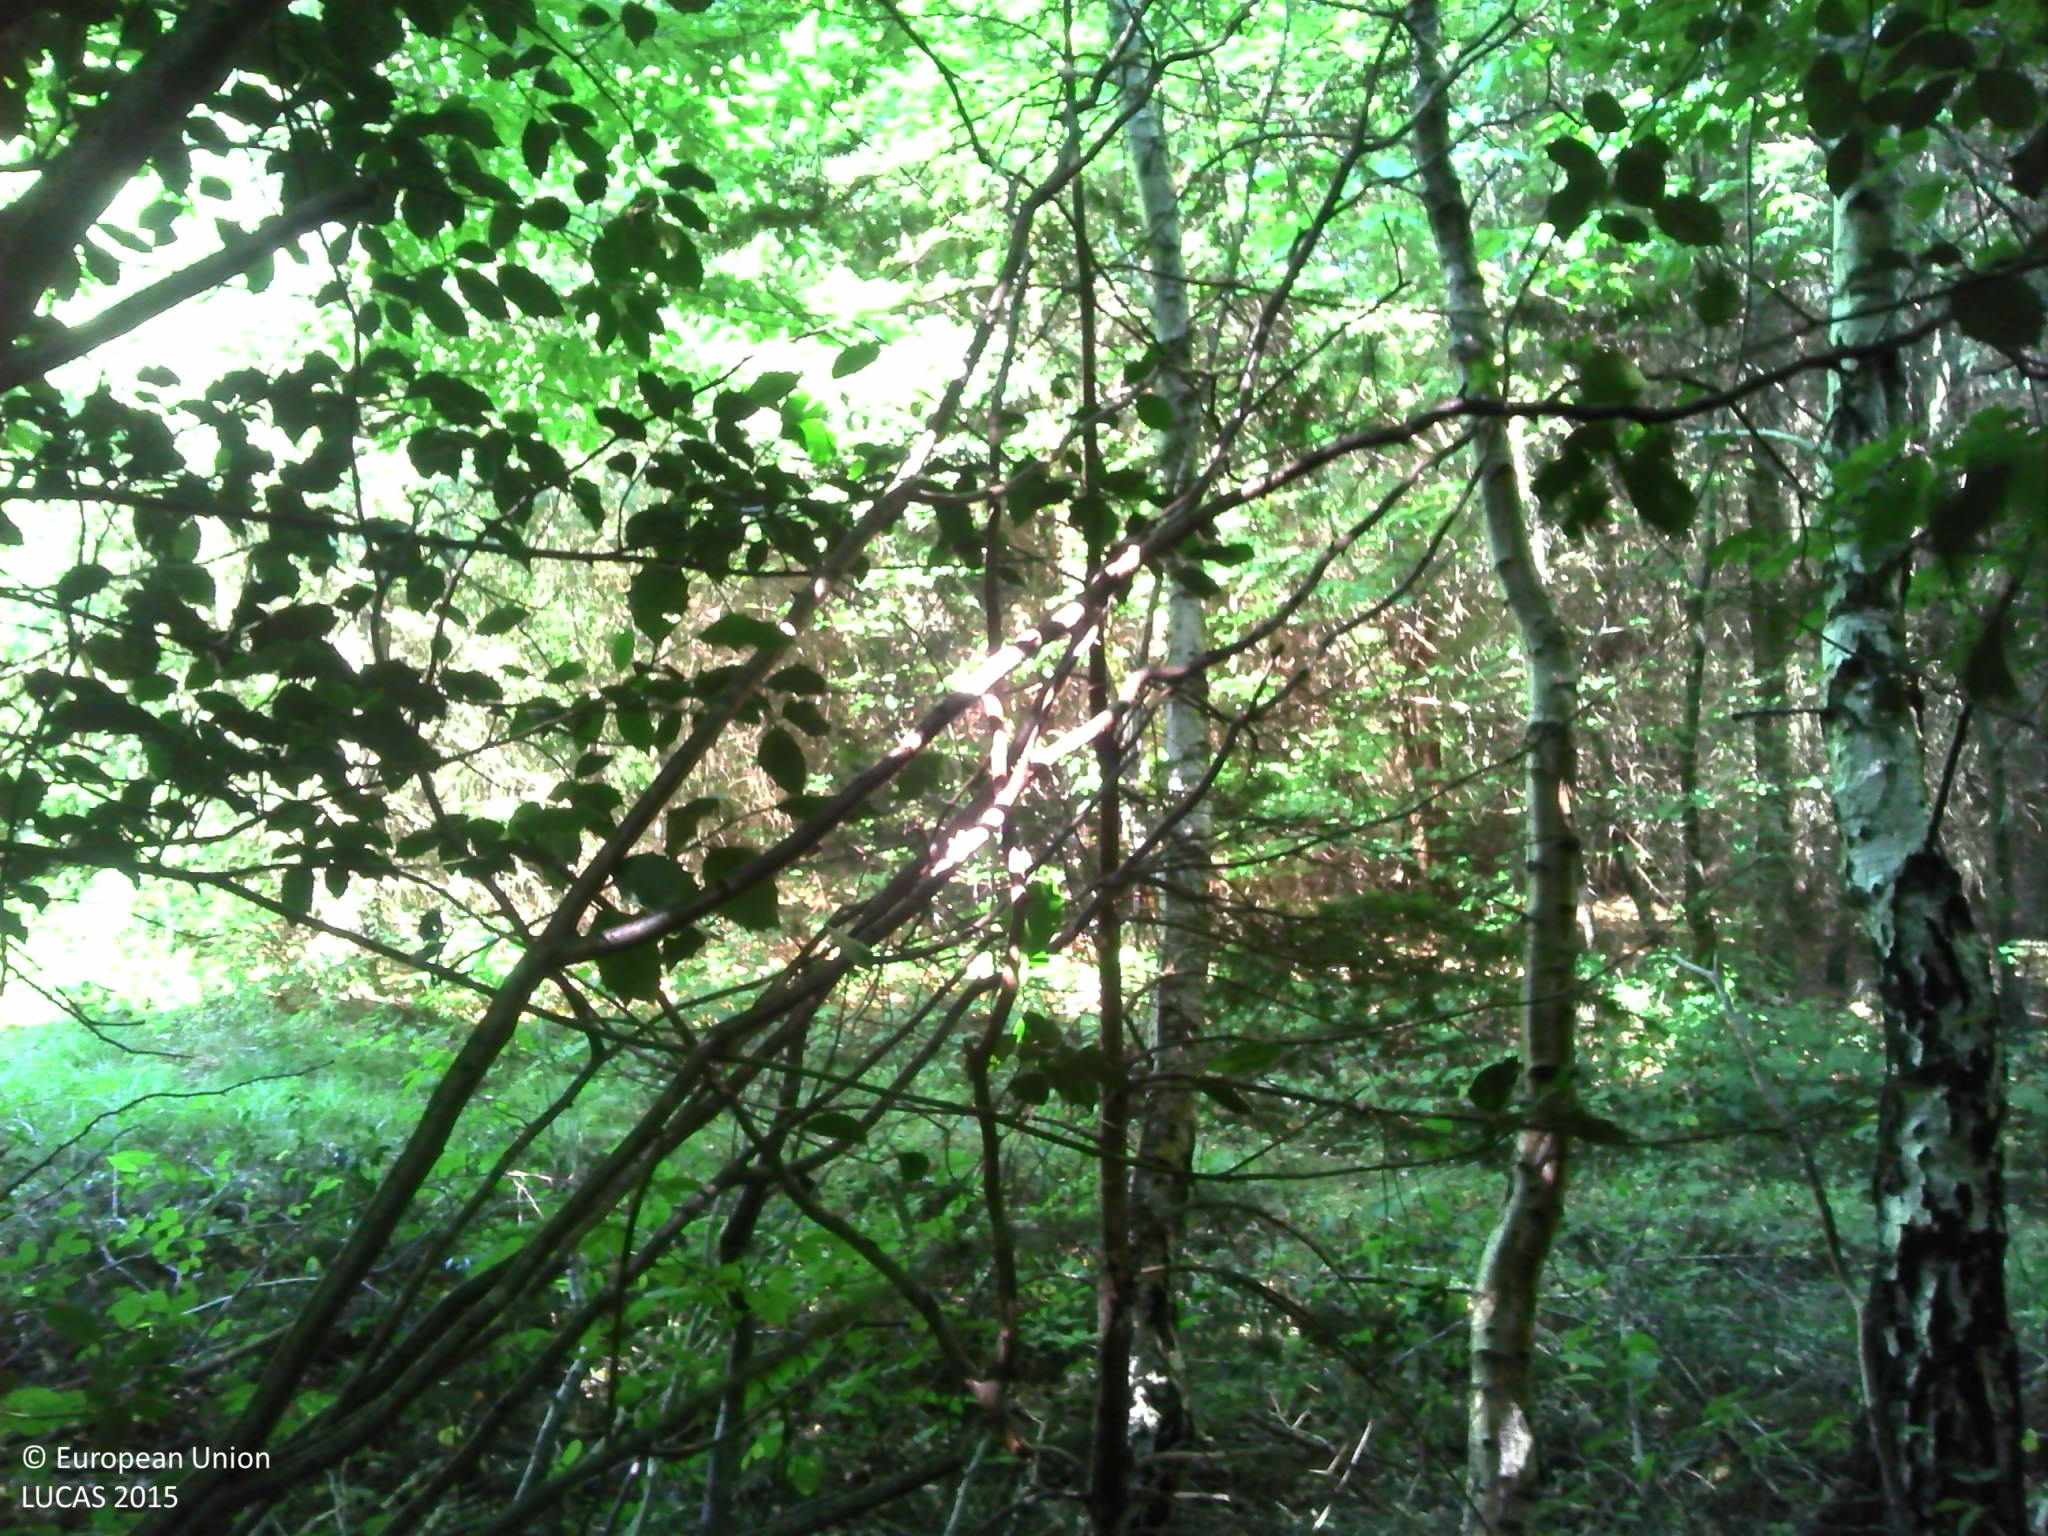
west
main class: Woodland
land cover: Broadleaved woodland
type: beech forest
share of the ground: > 75 %
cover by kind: broadleaved forest trees 75 %, consolidated bare surface 15 %, coniferous forest trees 5 %, herbaceous plants 5 %
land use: Forestry
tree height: > 5 m
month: July
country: FR
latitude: 45.4475
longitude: 5.1588
